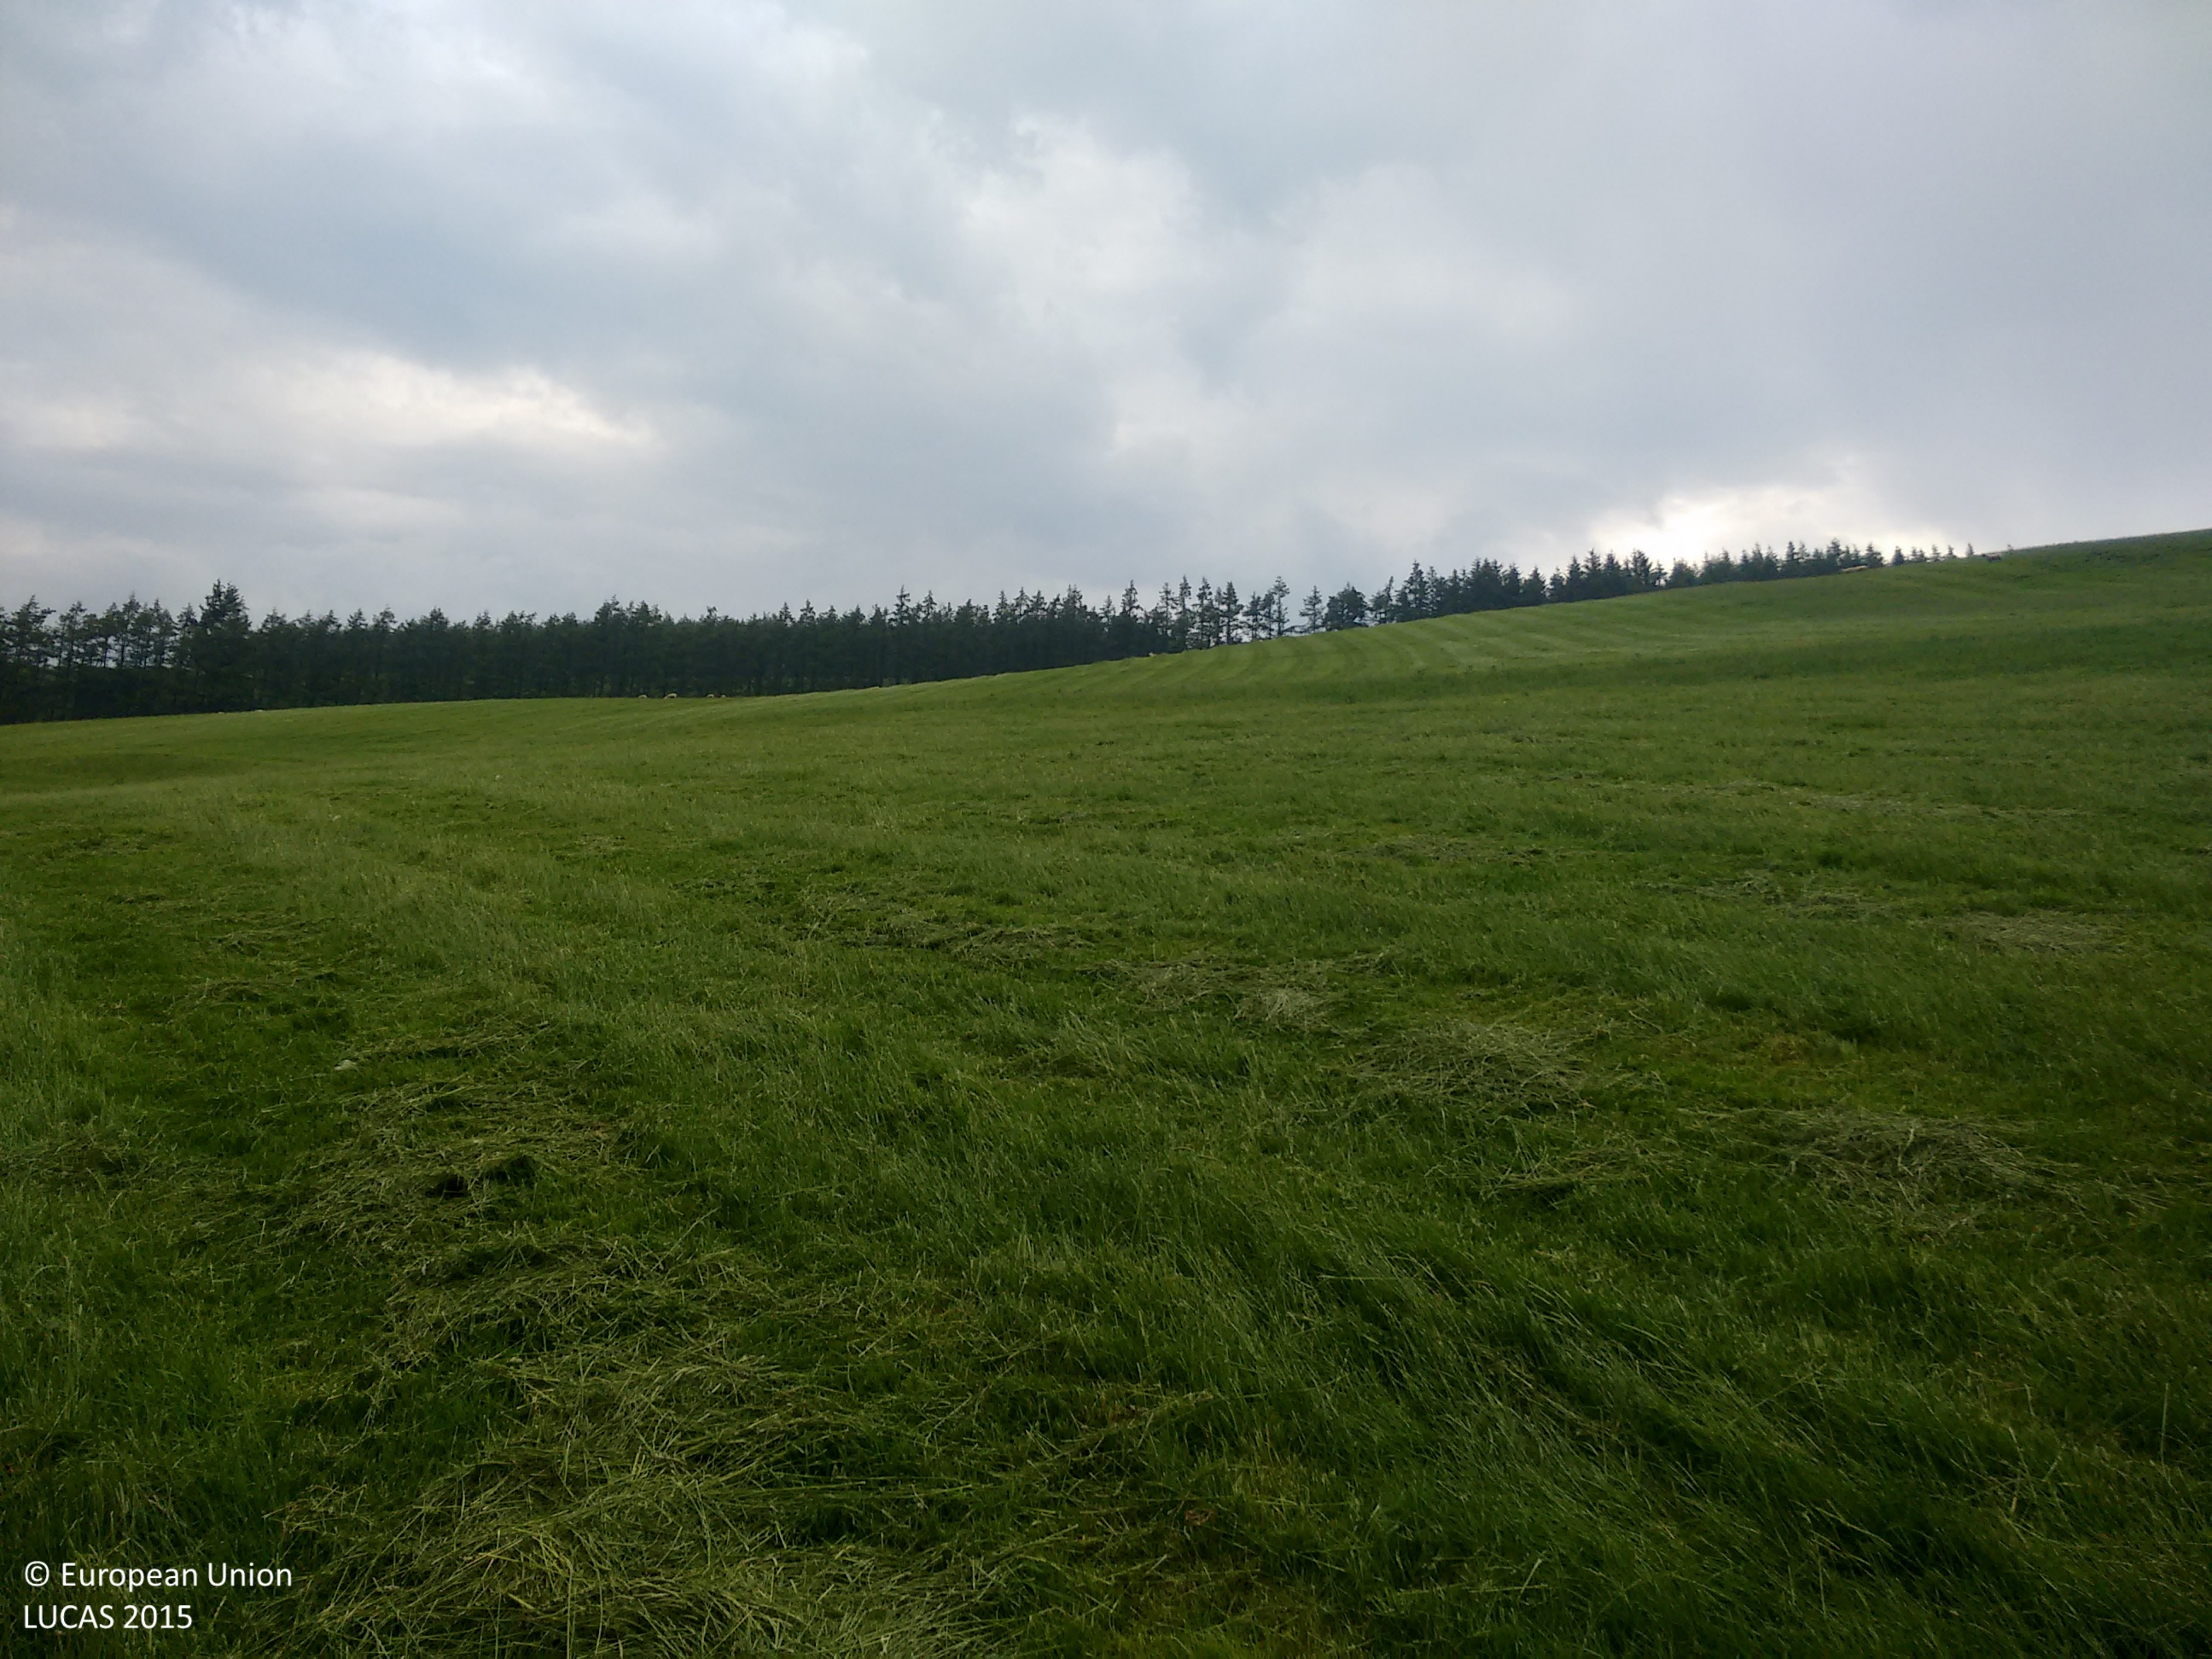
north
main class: Grassland
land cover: Grassland without tree/shrub cover
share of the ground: > 75 %
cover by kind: herbaceous plants 100 %
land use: Agriculture (excluding fallow land and kitchen gardens)
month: July
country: GB
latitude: 57.3804
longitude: -2.8498
